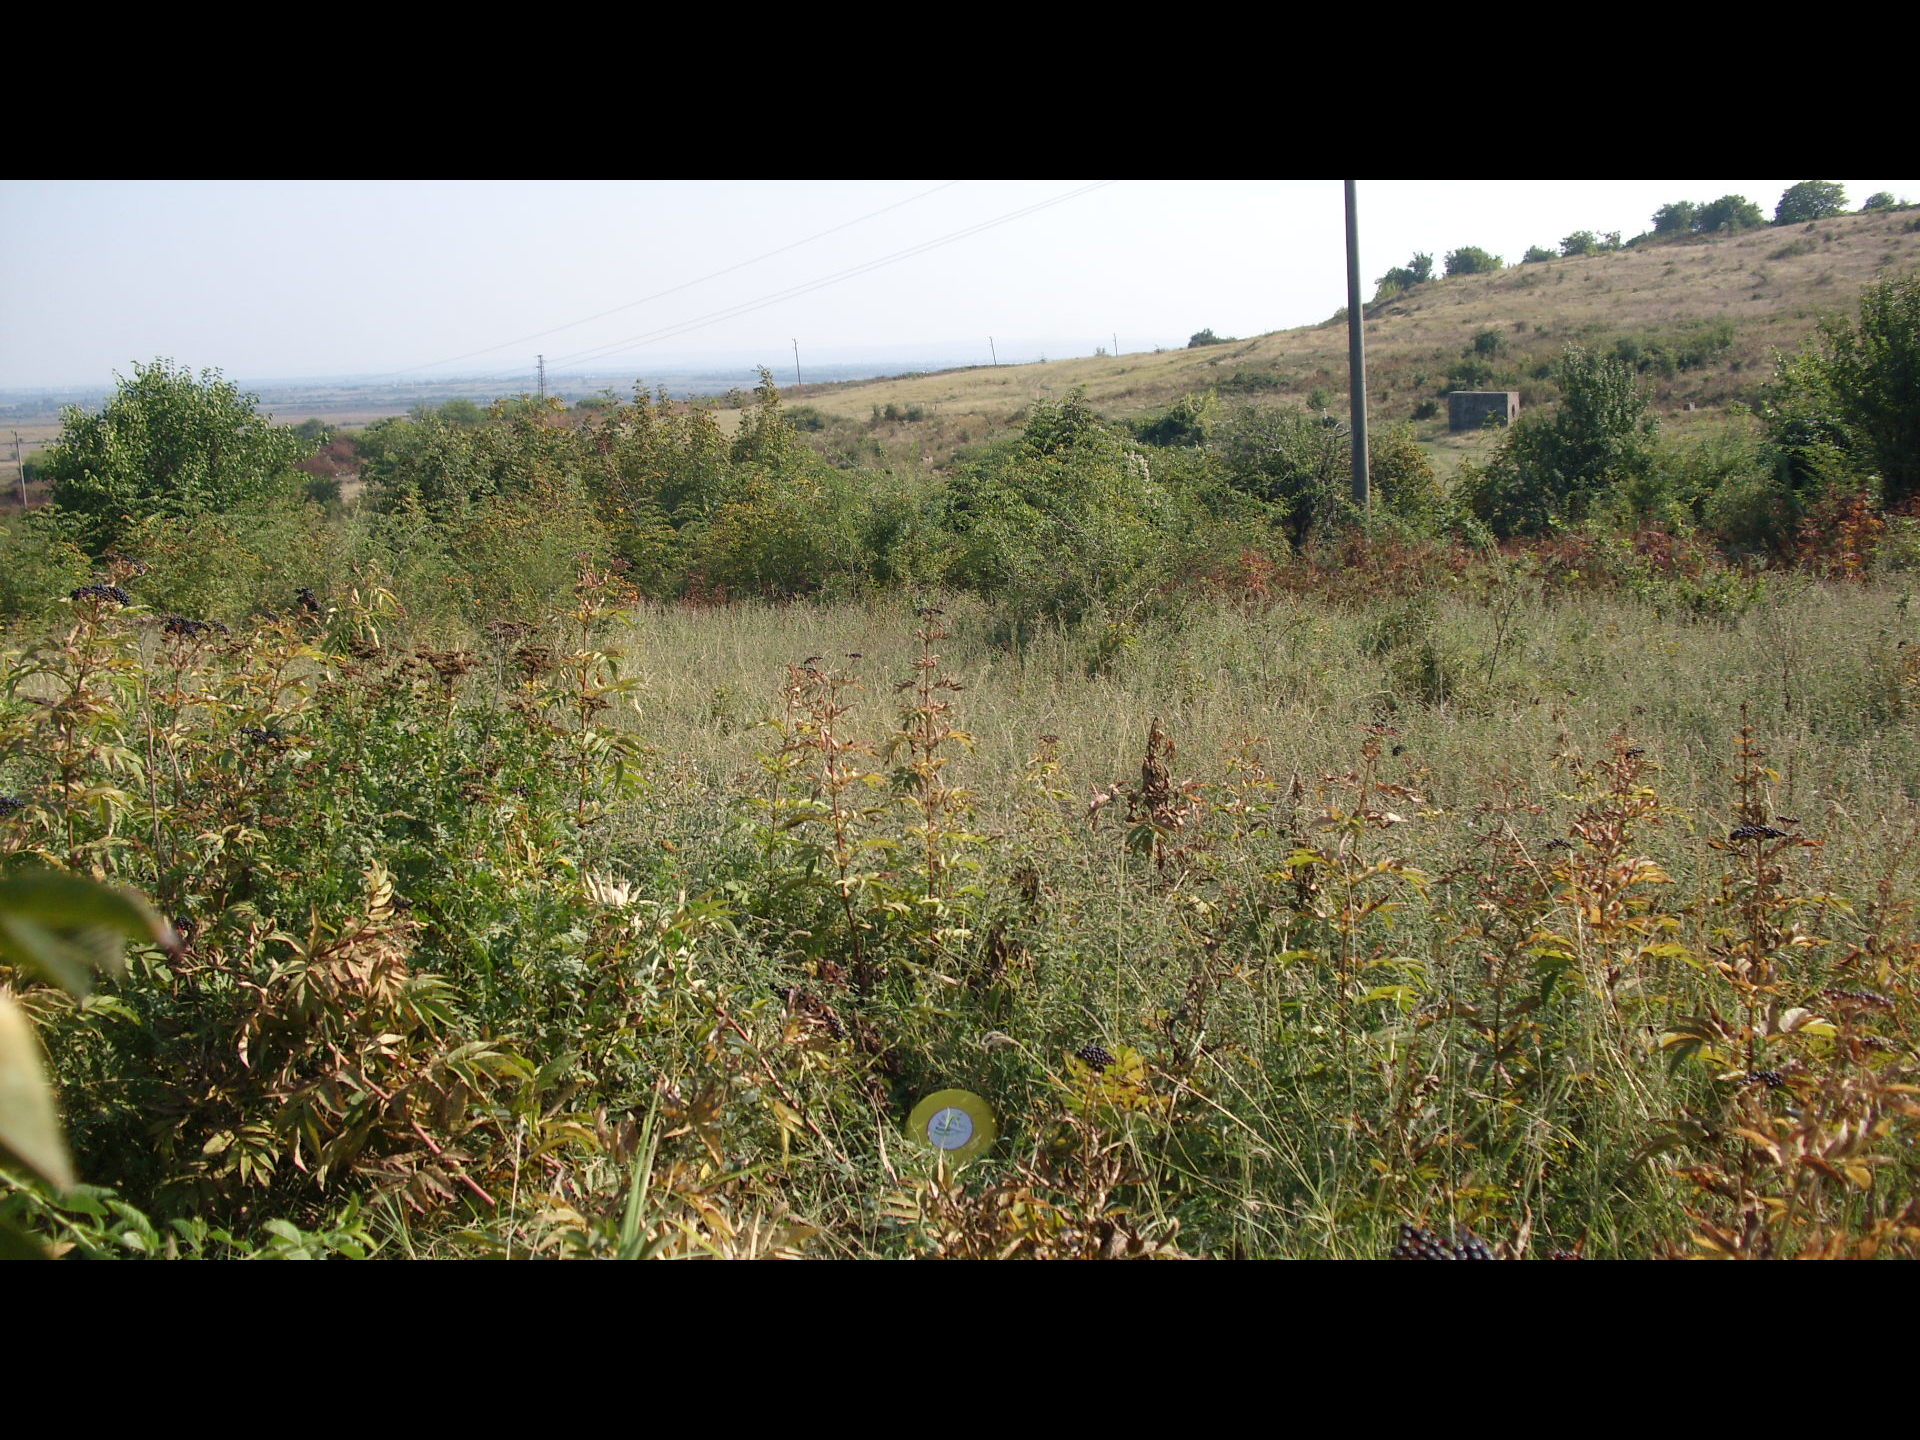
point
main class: Shrubland
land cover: Shrubland with sparse tree cover
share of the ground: > 75 %
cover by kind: herbaceous plants 85 %, shrubs 10 %, broadleaved forest trees 5 %
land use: Semi-natural and natural areas not in use
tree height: < 5 m
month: August
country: BG
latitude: 44.0490
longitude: 22.7820
